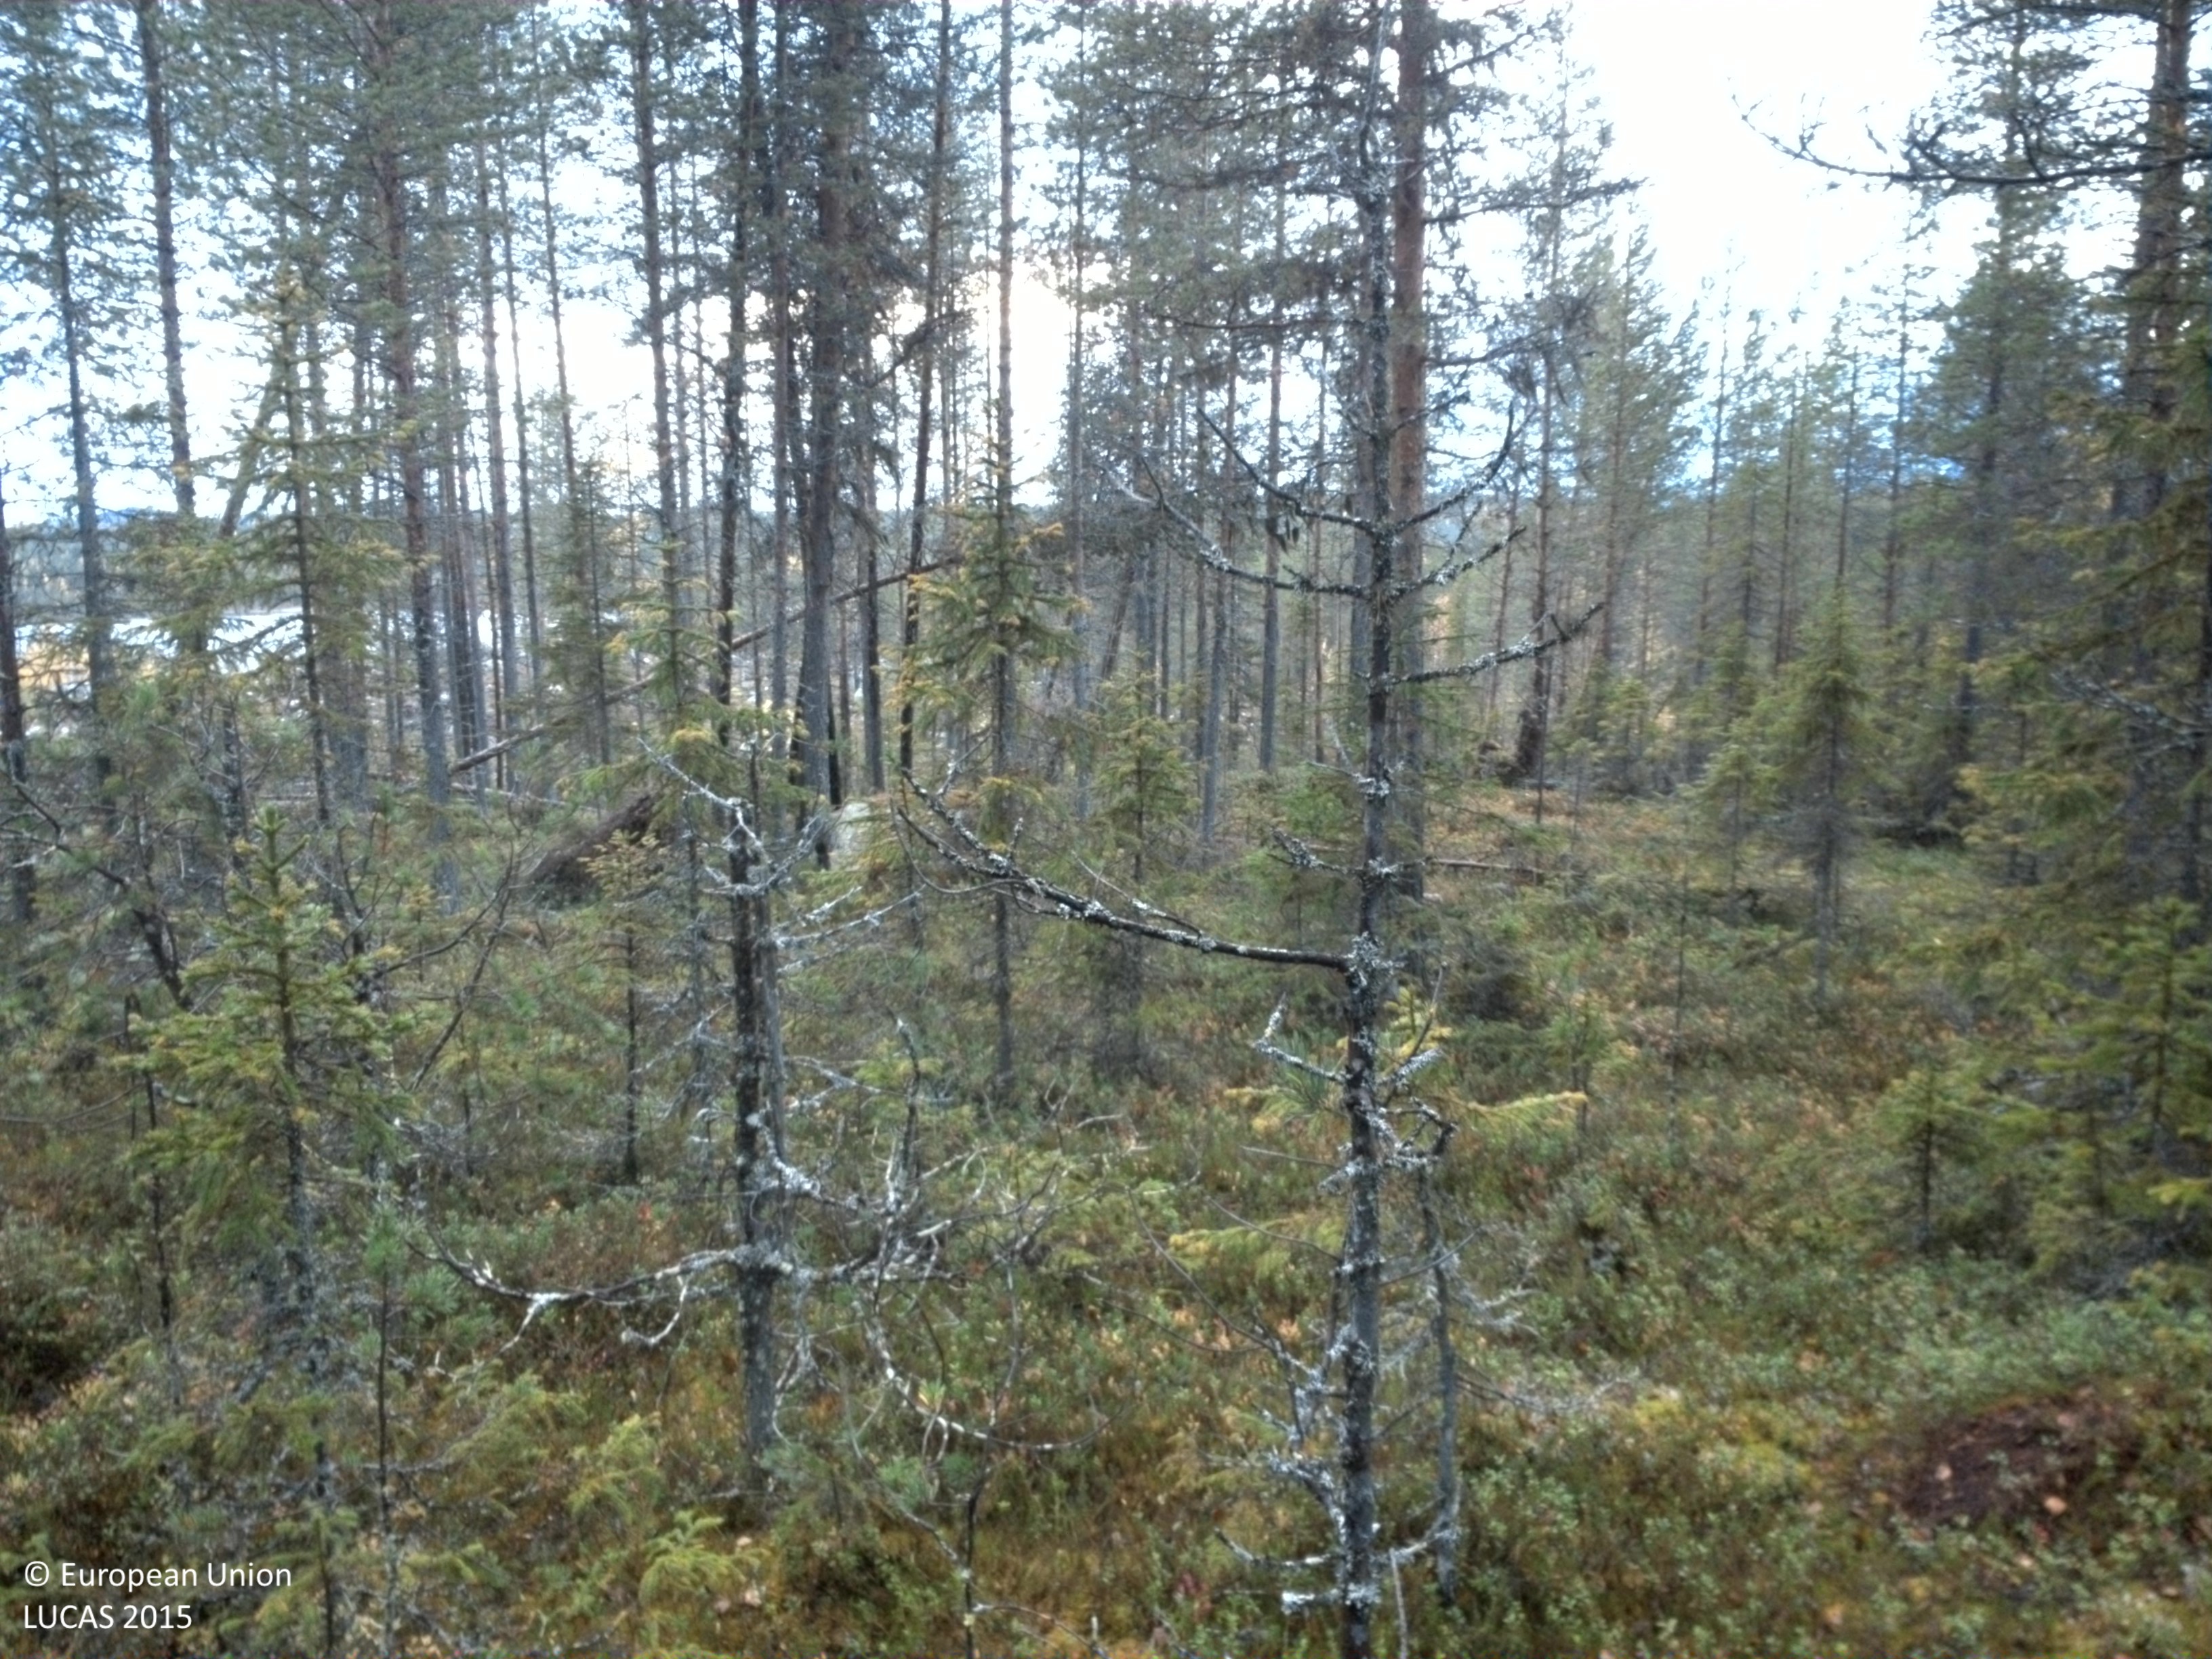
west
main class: Woodland
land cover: Other coniferous woodland
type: boreal forest
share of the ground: 25 - 50 %
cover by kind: coniferous forest trees 45 %, herbaceous plants 35 %, lichens and mosses 20 %
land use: Forestry
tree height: > 5 m
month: September
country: SE
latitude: 65.0876
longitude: 17.6011
